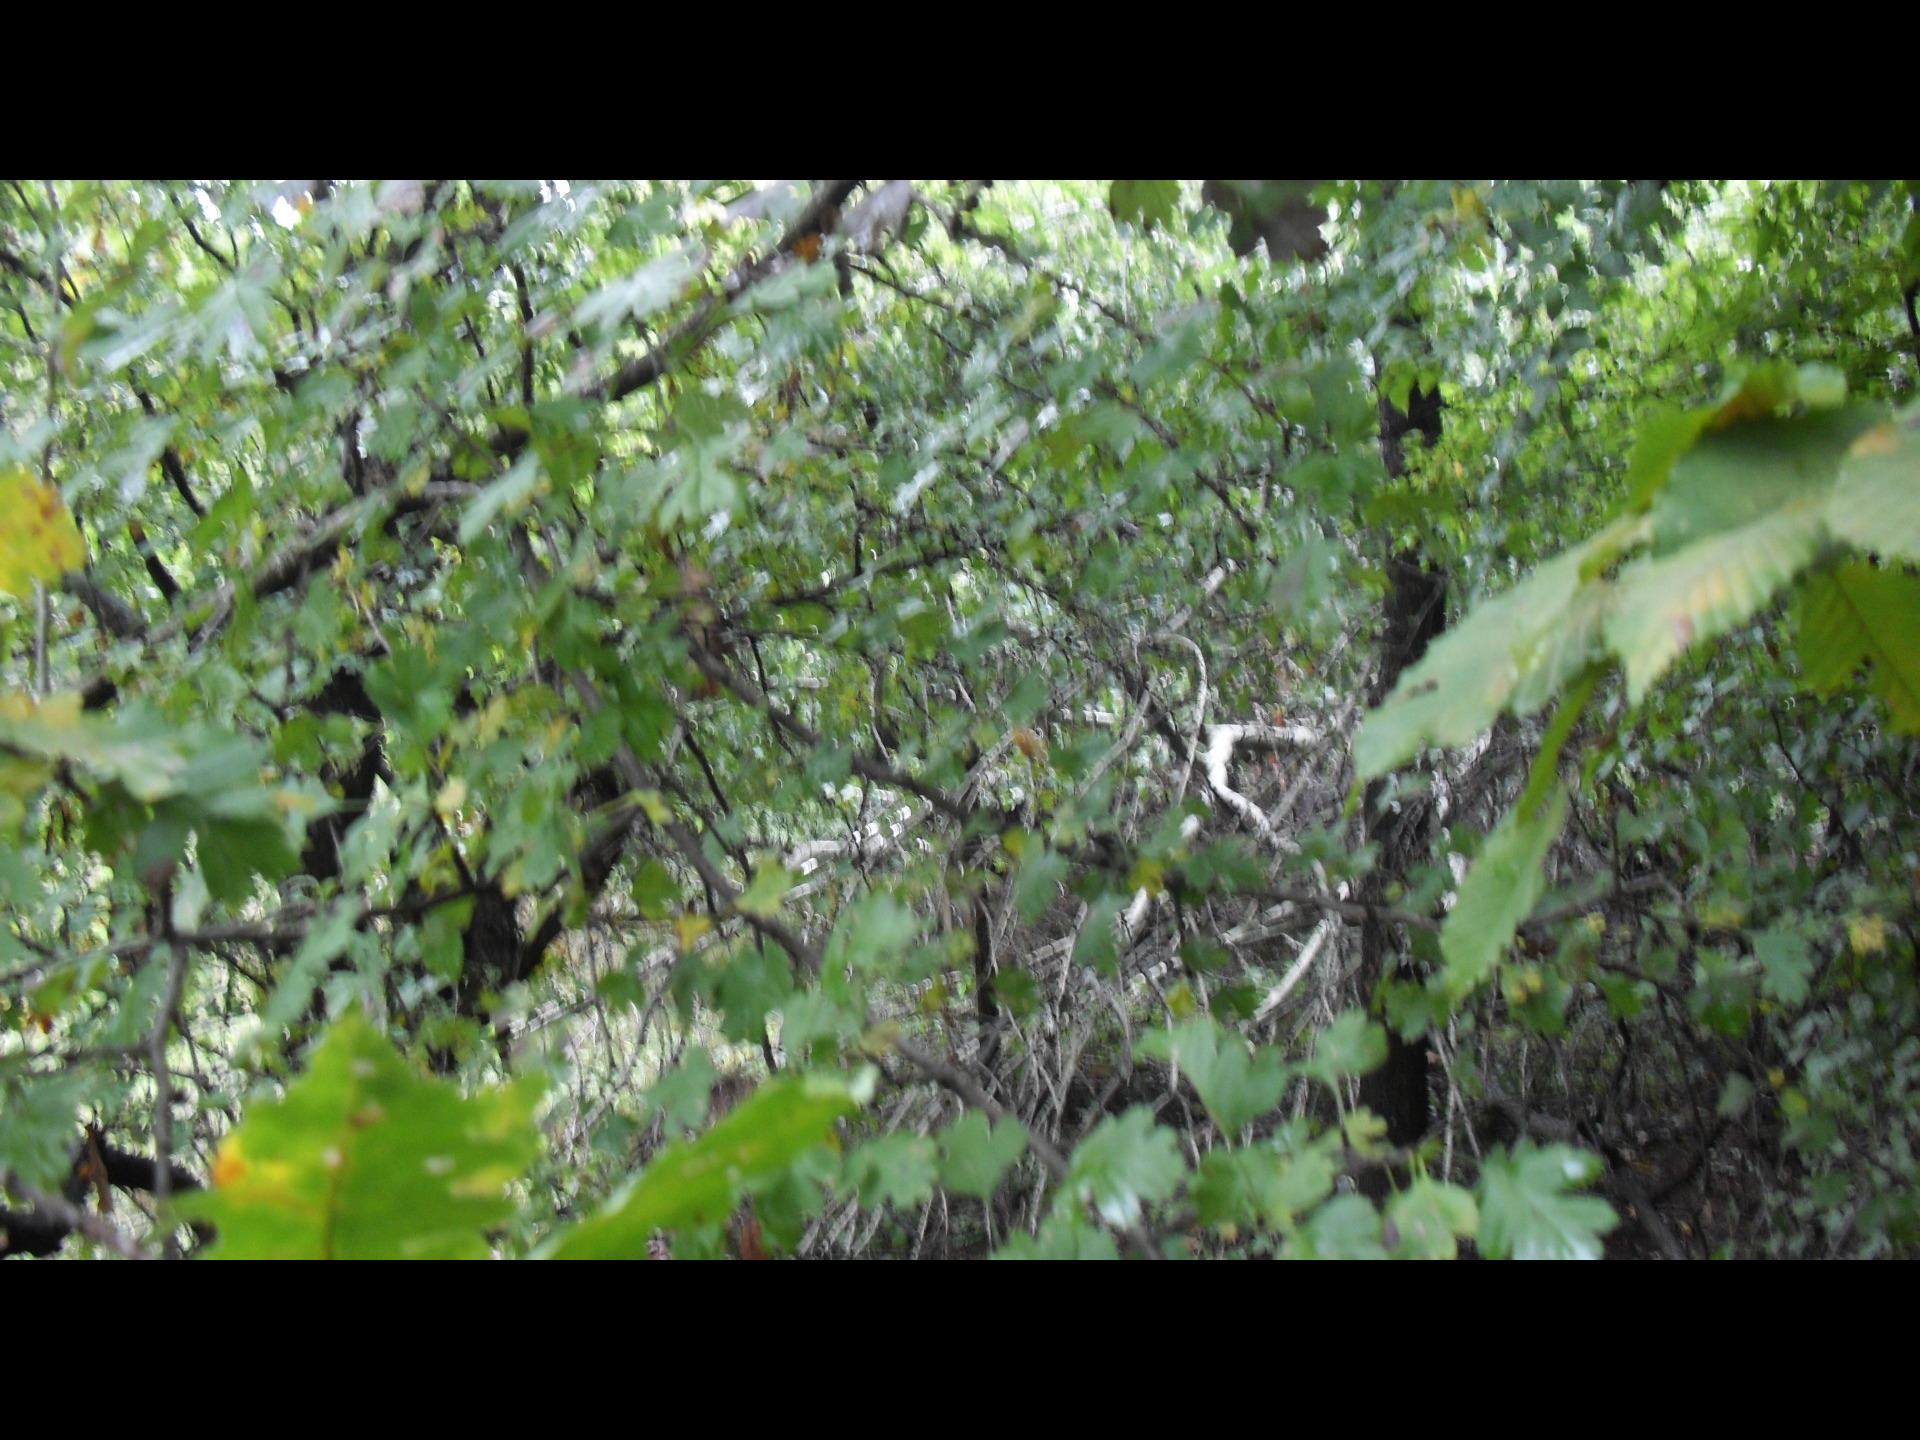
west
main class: Woodland
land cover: Broadleaved woodland
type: mesophytic deciduous forest
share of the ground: > 75 %
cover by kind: broadleaved forest trees 90 %, unconsolidated bare surface 10 %
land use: Forestry
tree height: > 5 m
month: October
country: BG
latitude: 43.4566
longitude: 22.8506
